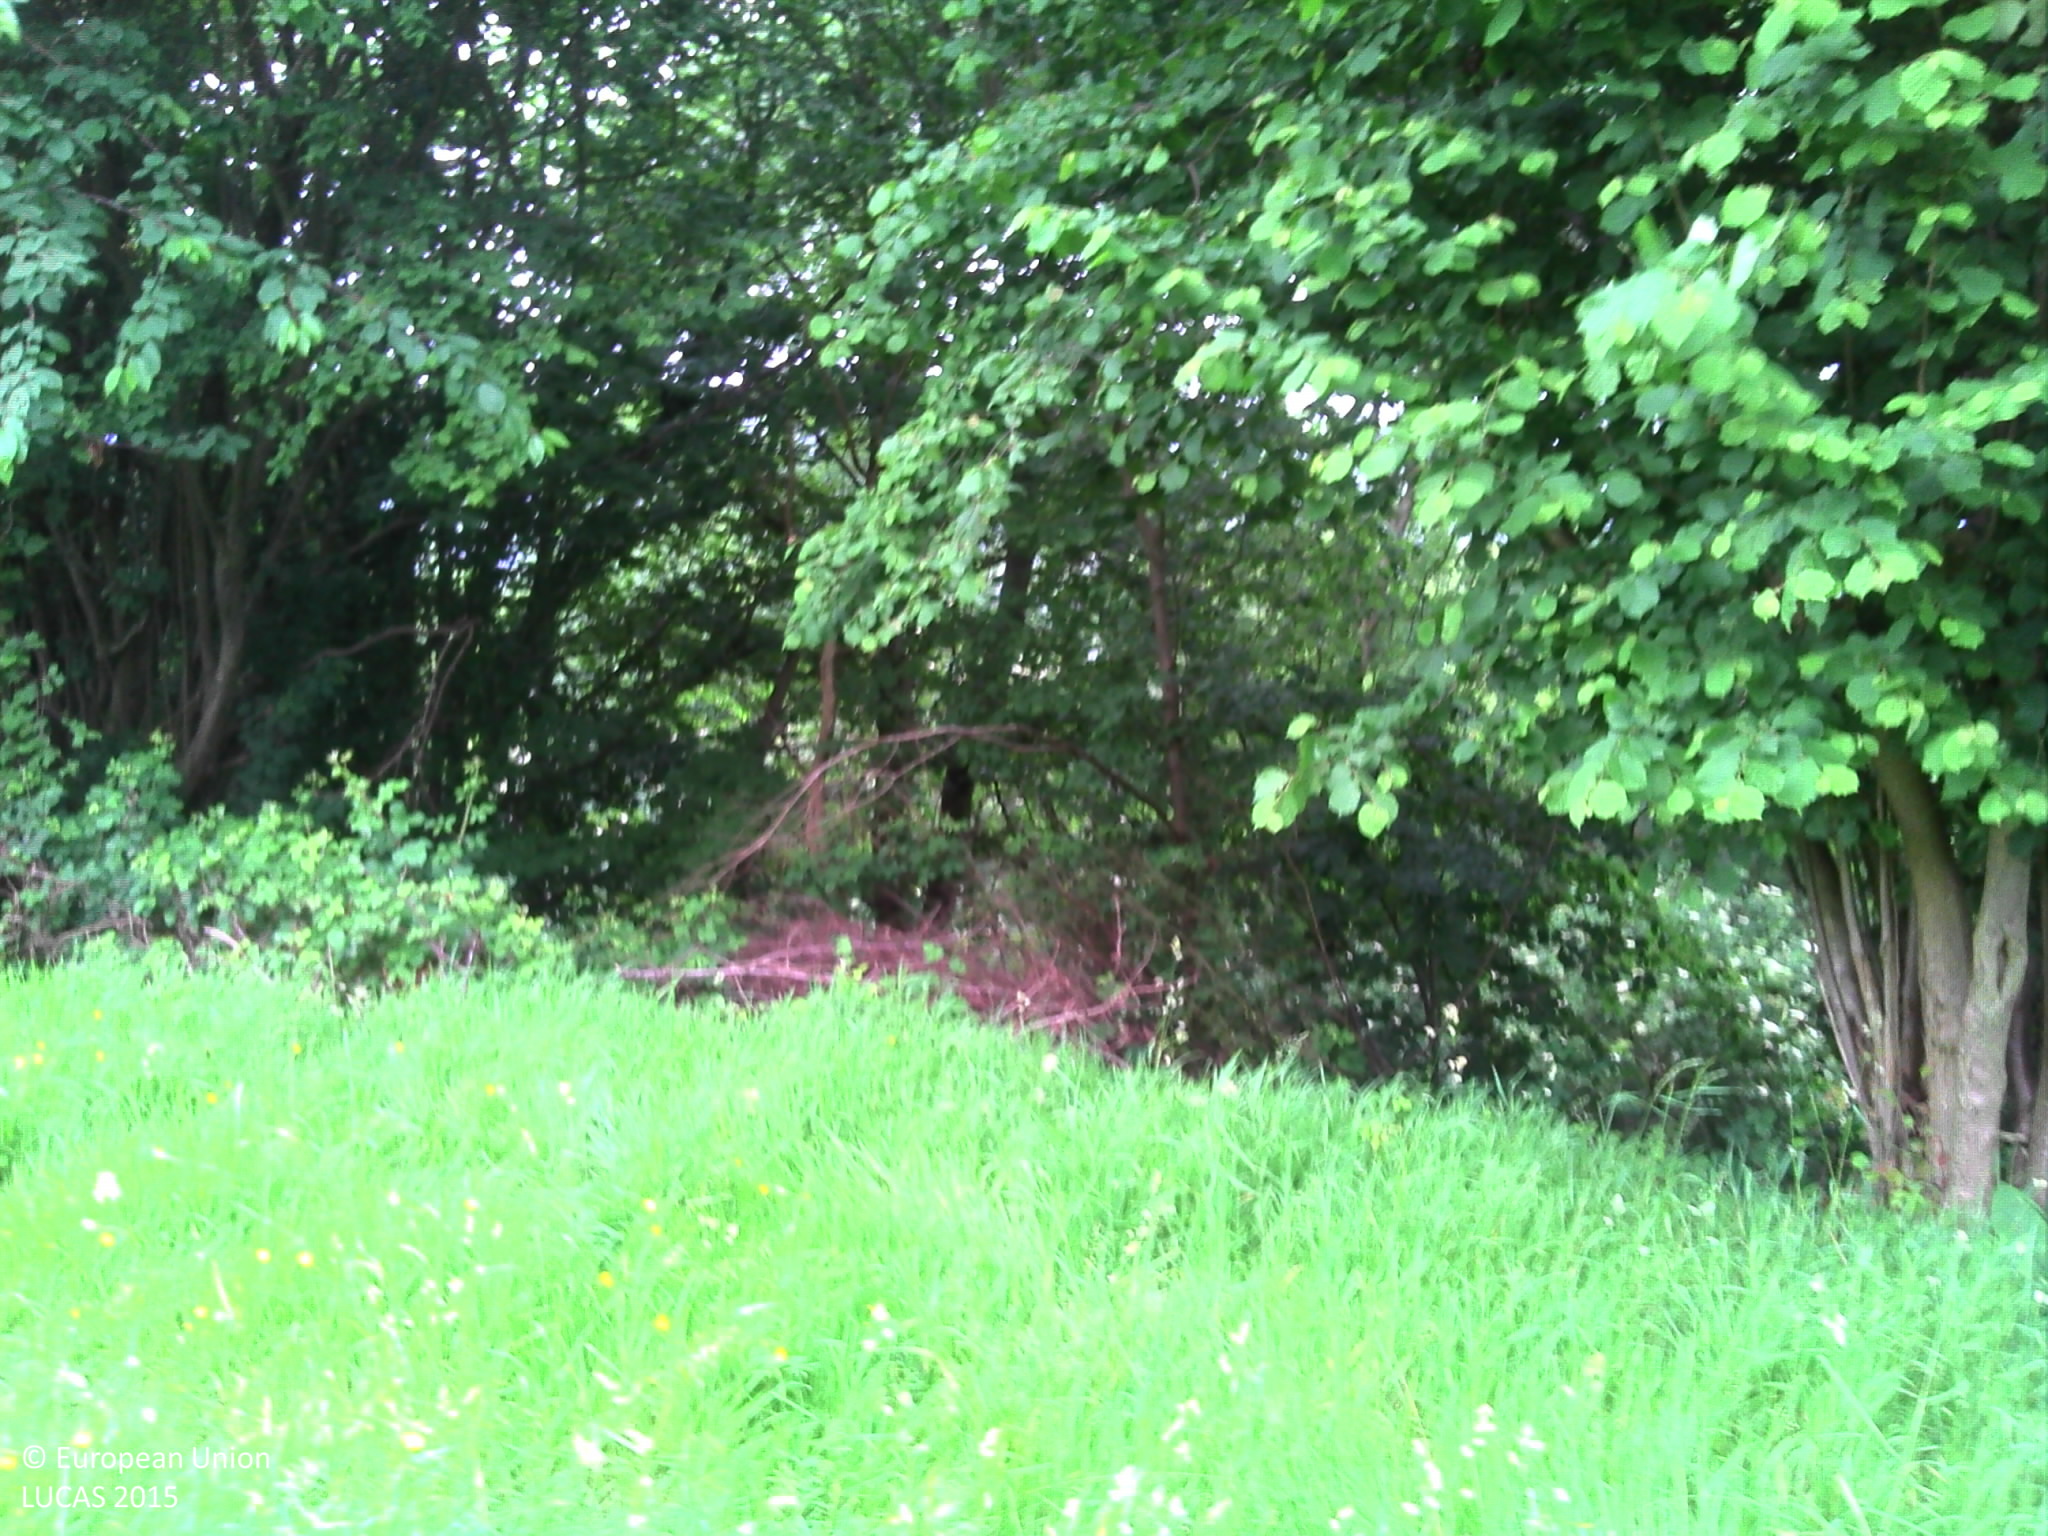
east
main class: Grassland
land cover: Grassland without tree/shrub cover
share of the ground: > 75 %
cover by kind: herbaceous plants 100 %
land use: Agriculture (excluding fallow land and kitchen gardens)
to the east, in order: Grassland without tree/shrub cover; Broadleaved woodland; Fences; Grassland without tree/shrub cover; Spontaneously vegetated surfaces; Broadleaved woodland; Grassland without tree/shrub cover
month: June
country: FR
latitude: 49.2500
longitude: -0.0466
